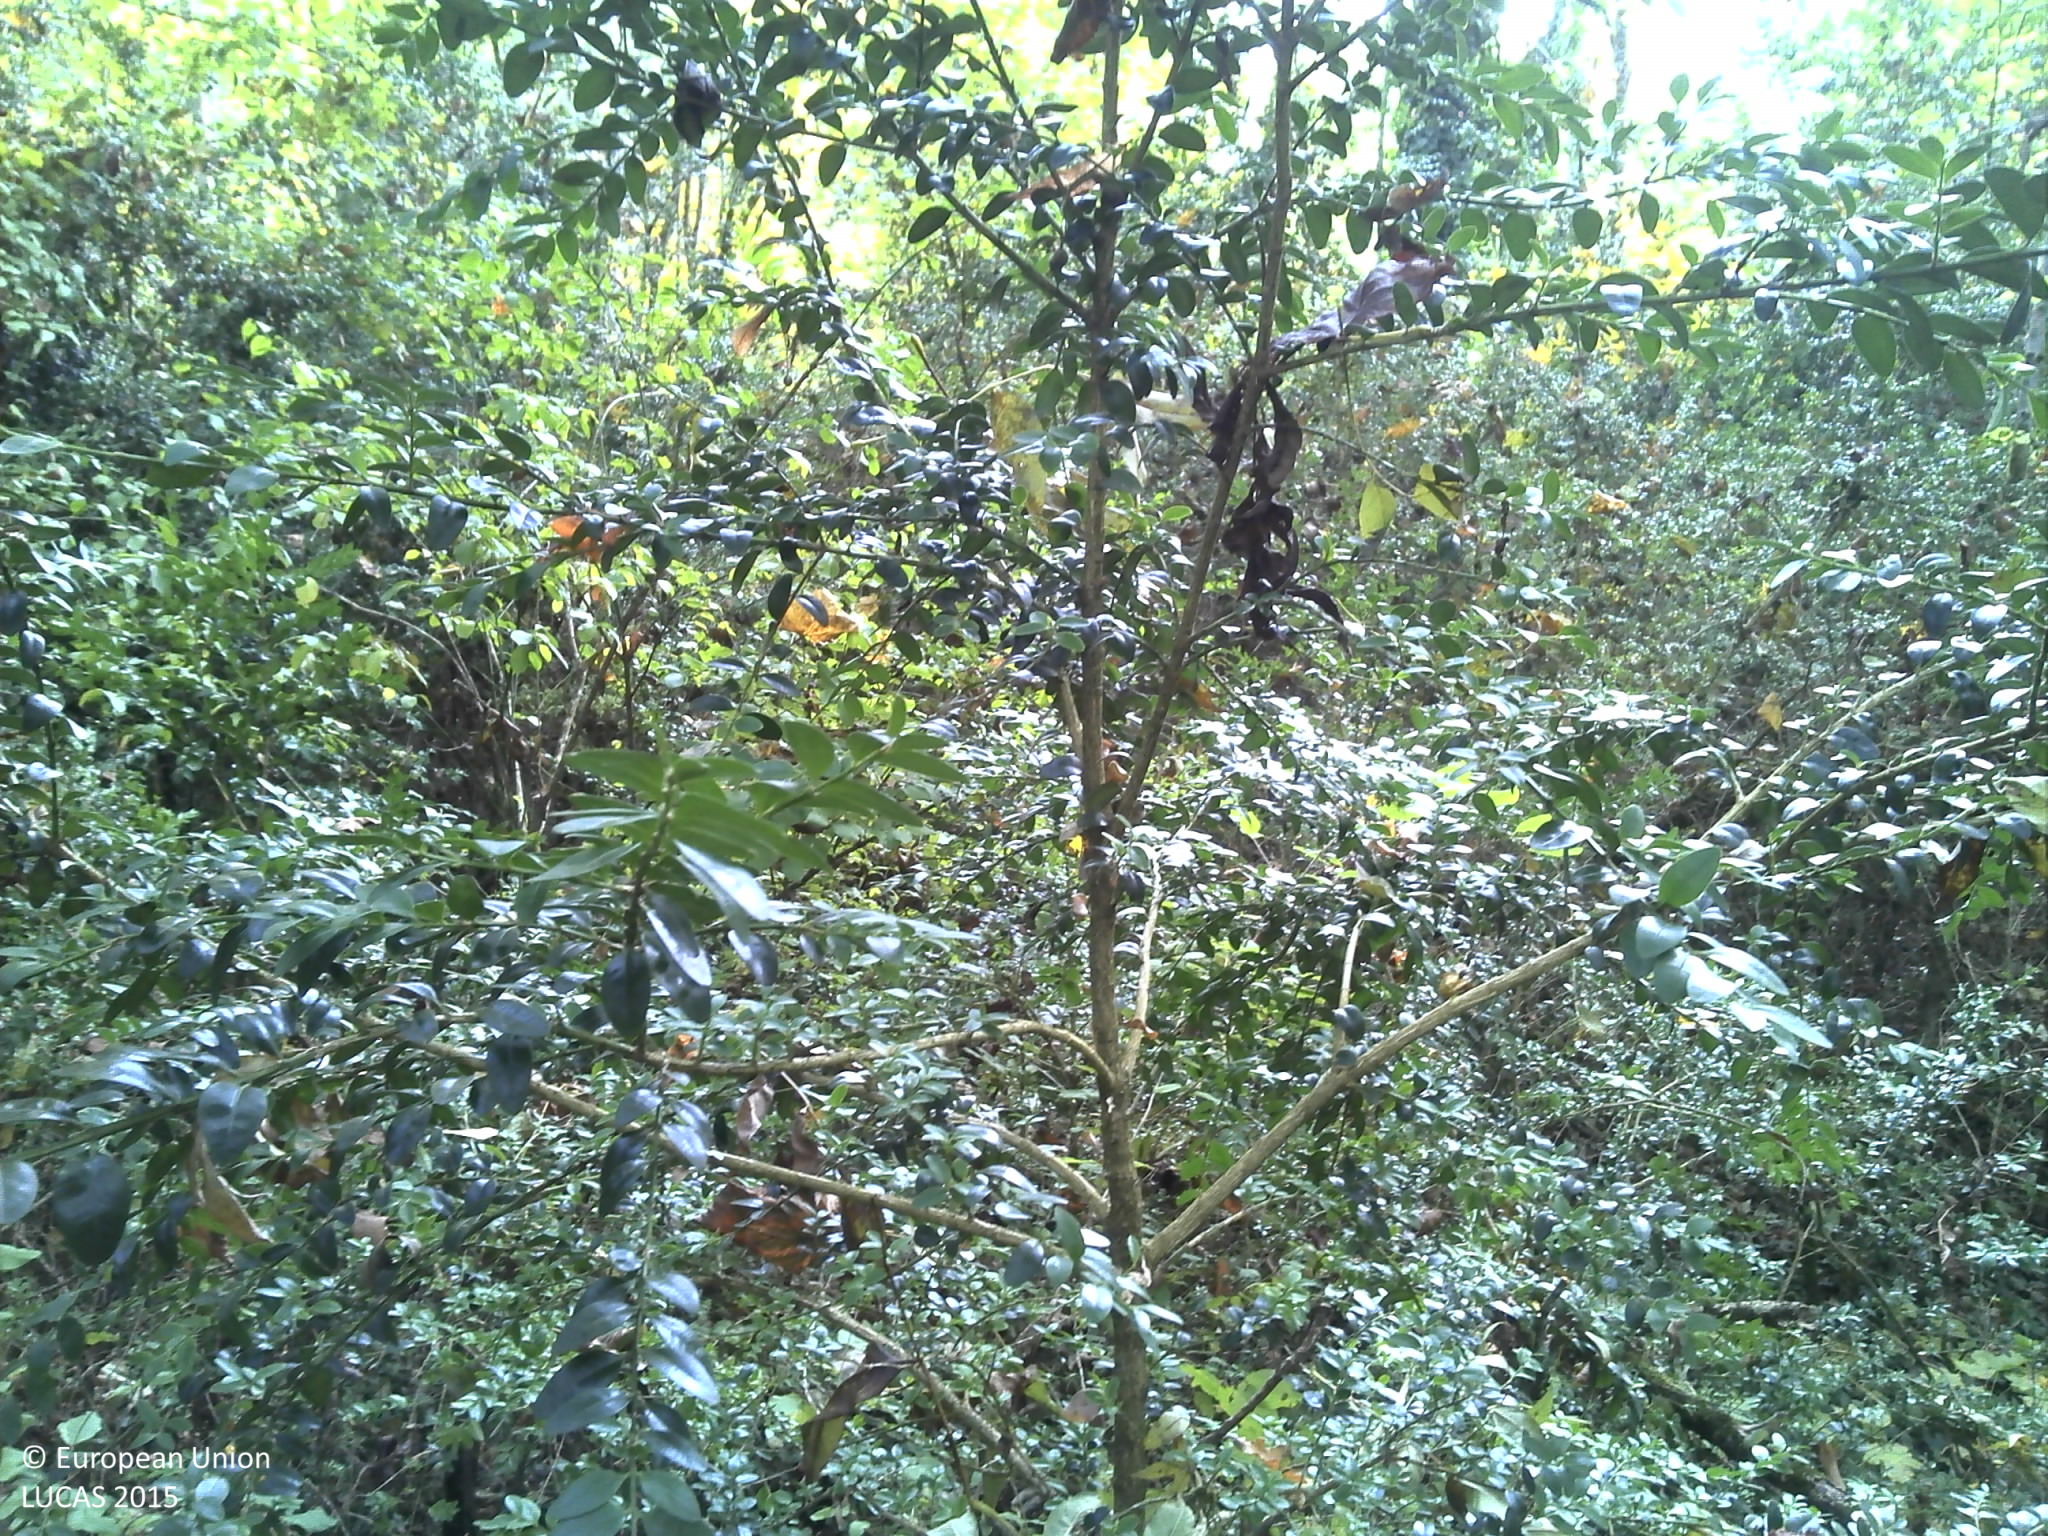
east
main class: Woodland
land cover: Broadleaved woodland
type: mesophytic deciduous forest
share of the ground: > 75 %
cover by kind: broadleaved forest trees 90 %, shrubs 5 %, herbaceous plants 5 %
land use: Forestry
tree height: > 5 m
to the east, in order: Broadleaved woodland; Tracks; Broadleaved woodland; Tracks; Broadleaved woodland
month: October
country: FR
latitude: 46.0882
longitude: 5.3604
